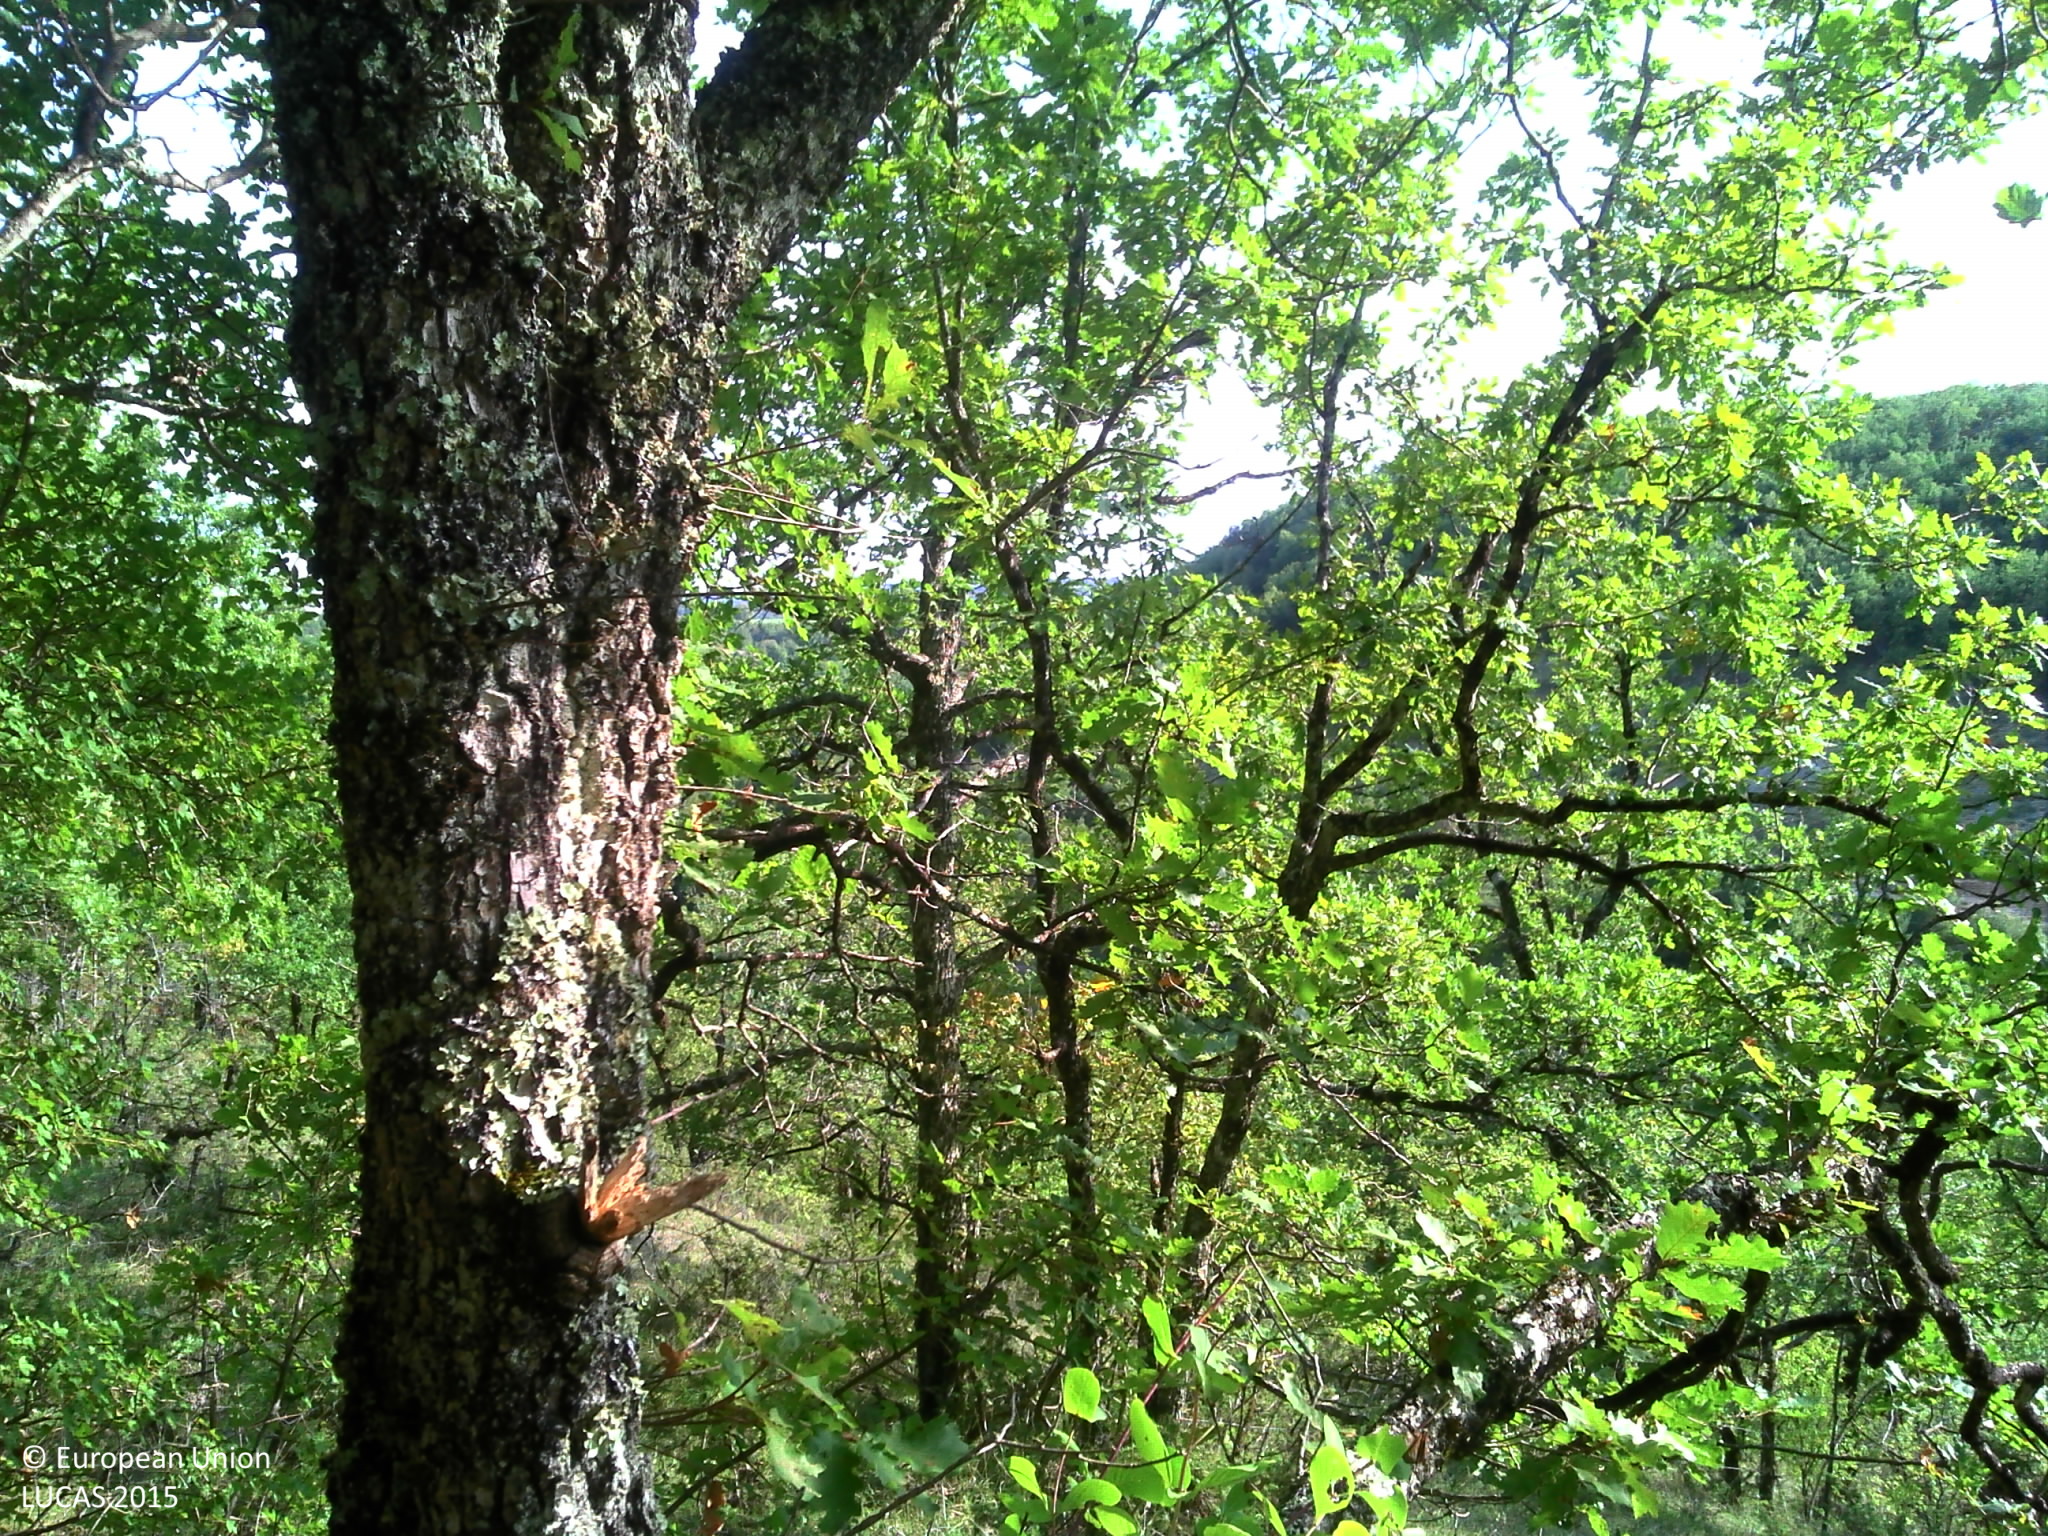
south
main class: Woodland
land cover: Broadleaved woodland
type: thermophilous deciduous forest
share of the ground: > 75 %
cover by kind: broadleaved forest trees 60 %, herbaceous plants 30 %, shrubs 10 %
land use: Forestry
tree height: > 5 m
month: September
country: FR
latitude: 44.6885
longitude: 1.4803
